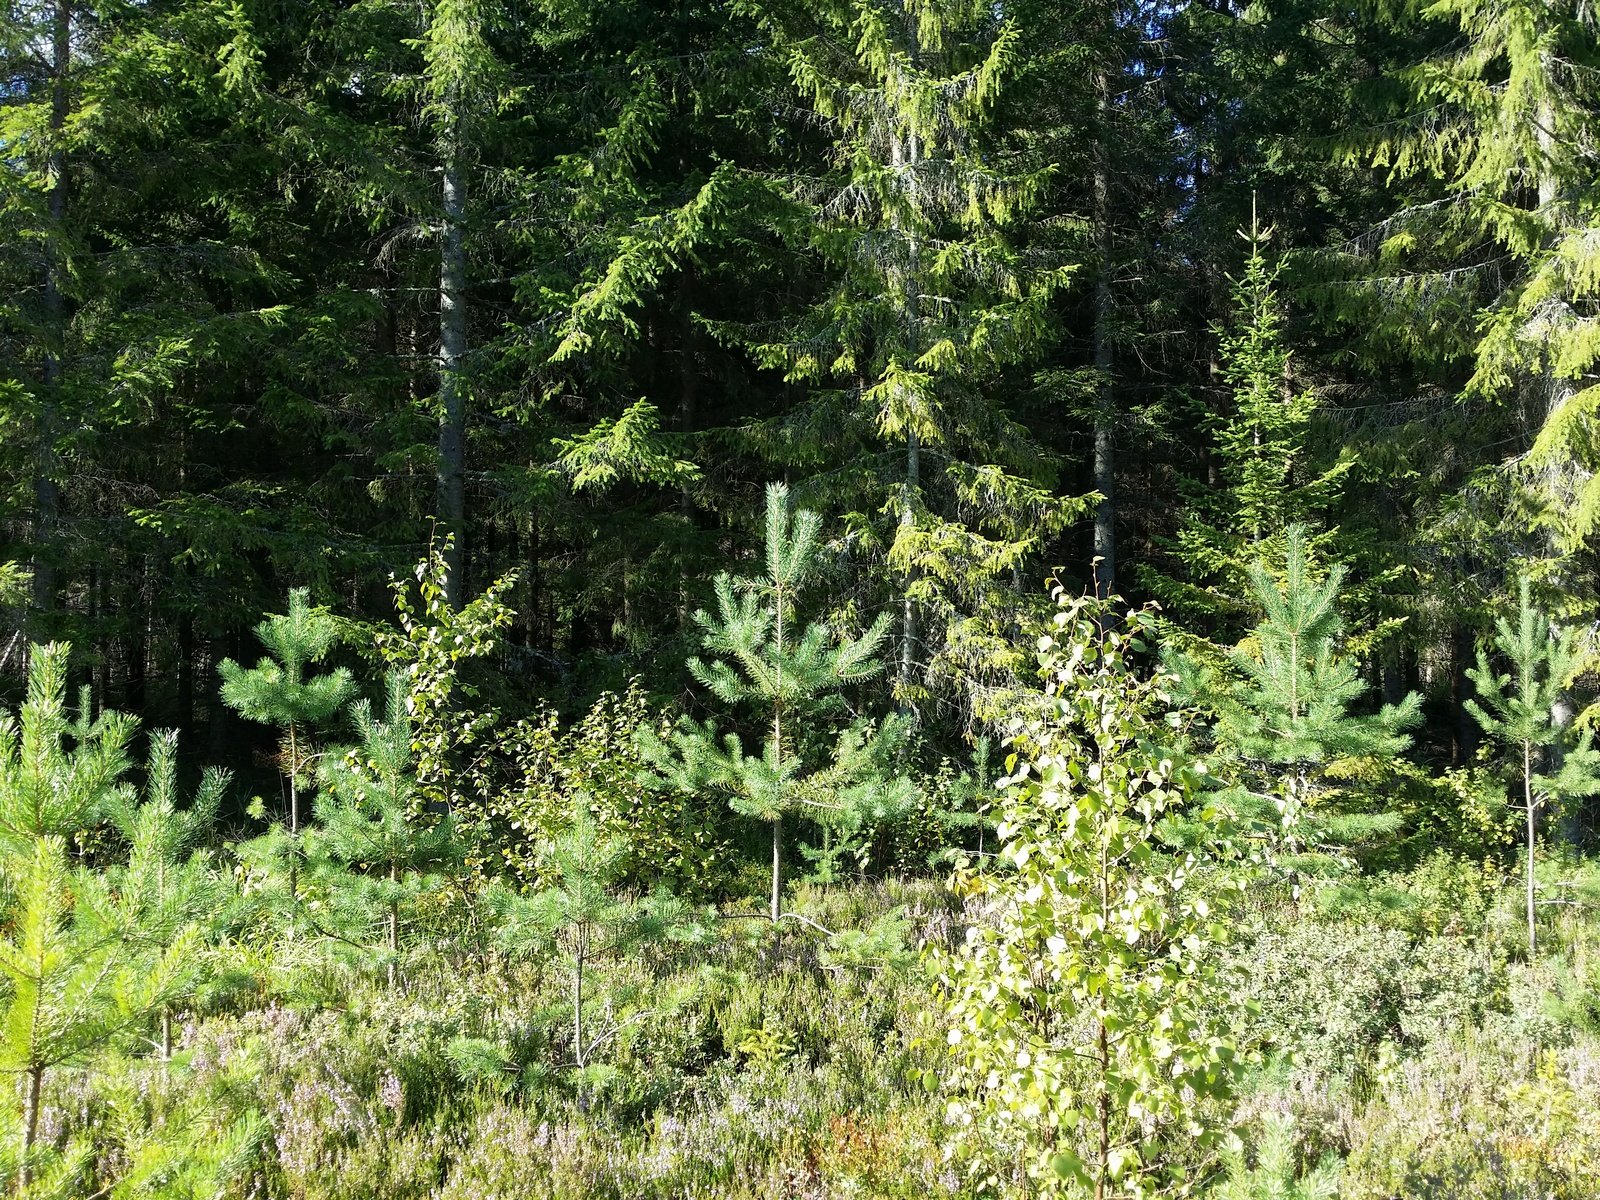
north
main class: Woodland
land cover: Other mixed woodland
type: hemiboreal forest and nemoral coniferous forest and mixed broadleaved-coniferous forest
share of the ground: 25 - 50 %
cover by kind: lichens and mosses 50 %, broadleaved forest trees 25 %, coniferous forest trees 15 %, herbaceous plants 10 %
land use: Forestry
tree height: < 5 m
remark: Nursery
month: August
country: LV
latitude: 57.2643
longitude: 27.6048
